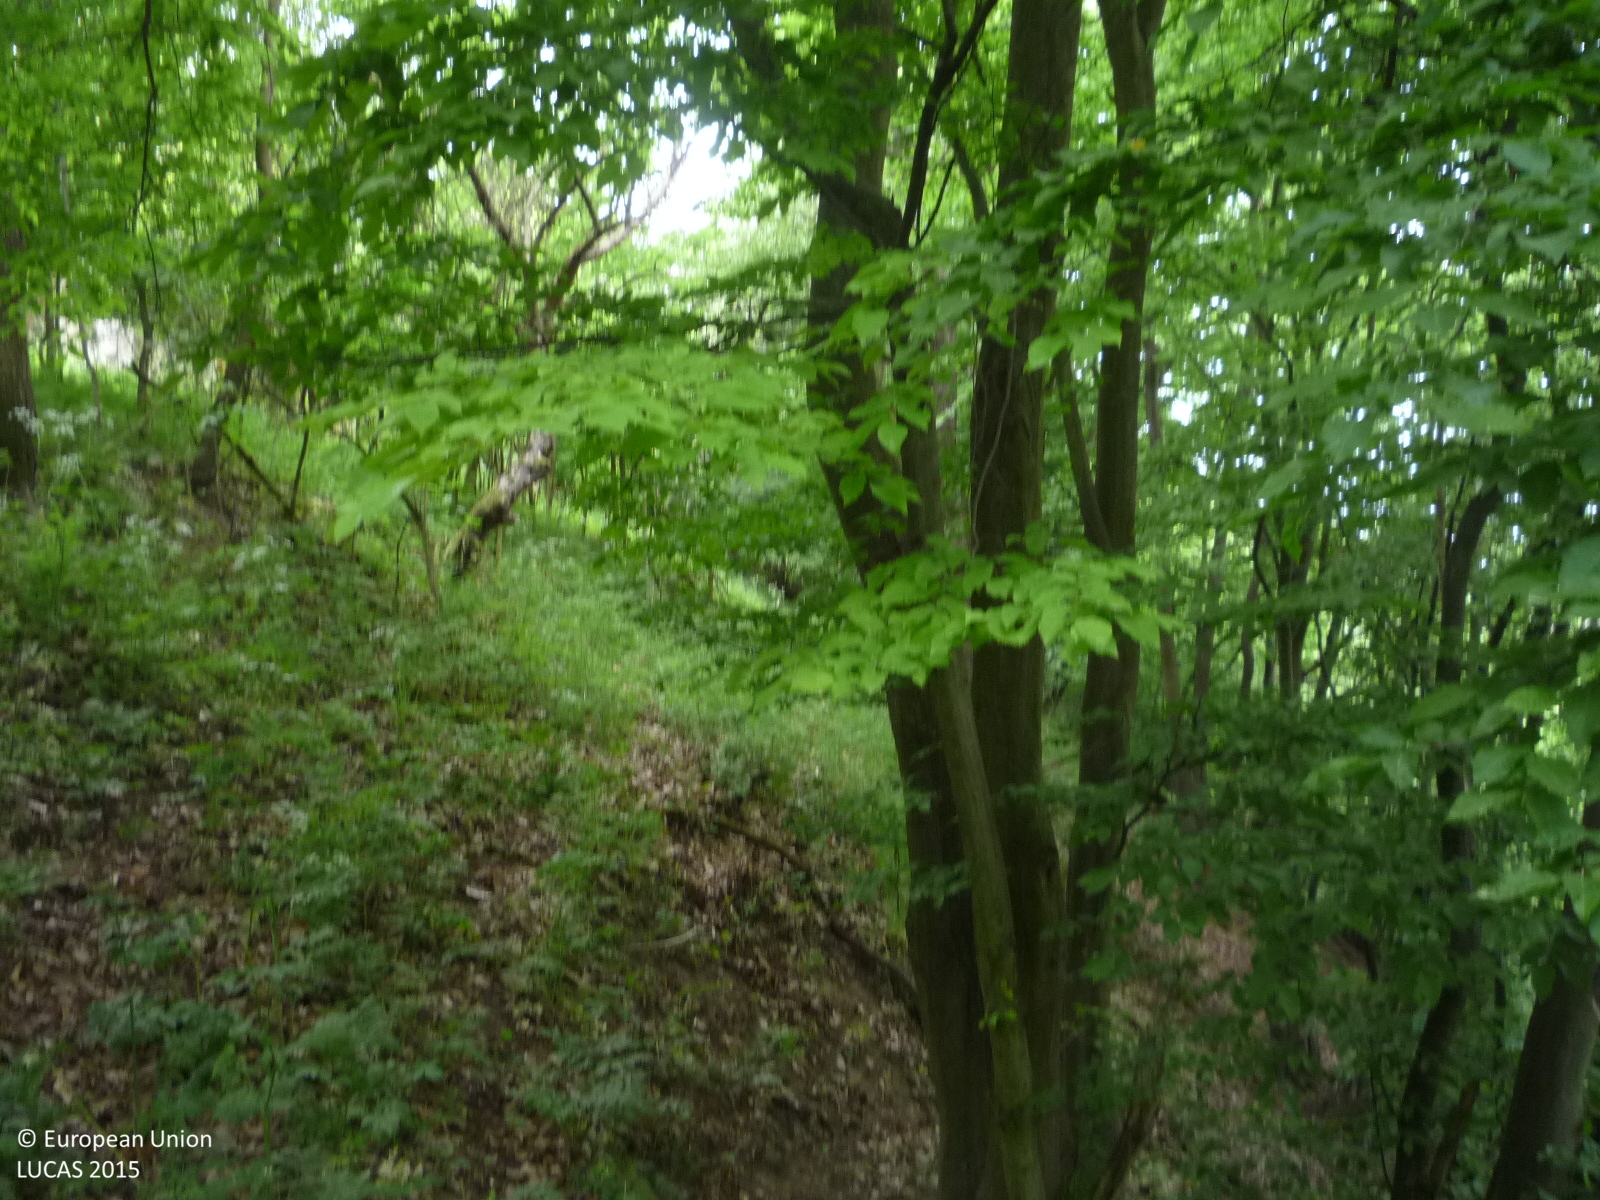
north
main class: Woodland
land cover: Broadleaved woodland
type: mesophytic deciduous forest
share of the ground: > 75 %
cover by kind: broadleaved forest trees 90 %, herbaceous plants 10 %
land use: Semi-natural and natural areas not in use
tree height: > 5 m
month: May
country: CZ
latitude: 50.4357
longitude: 14.5494
